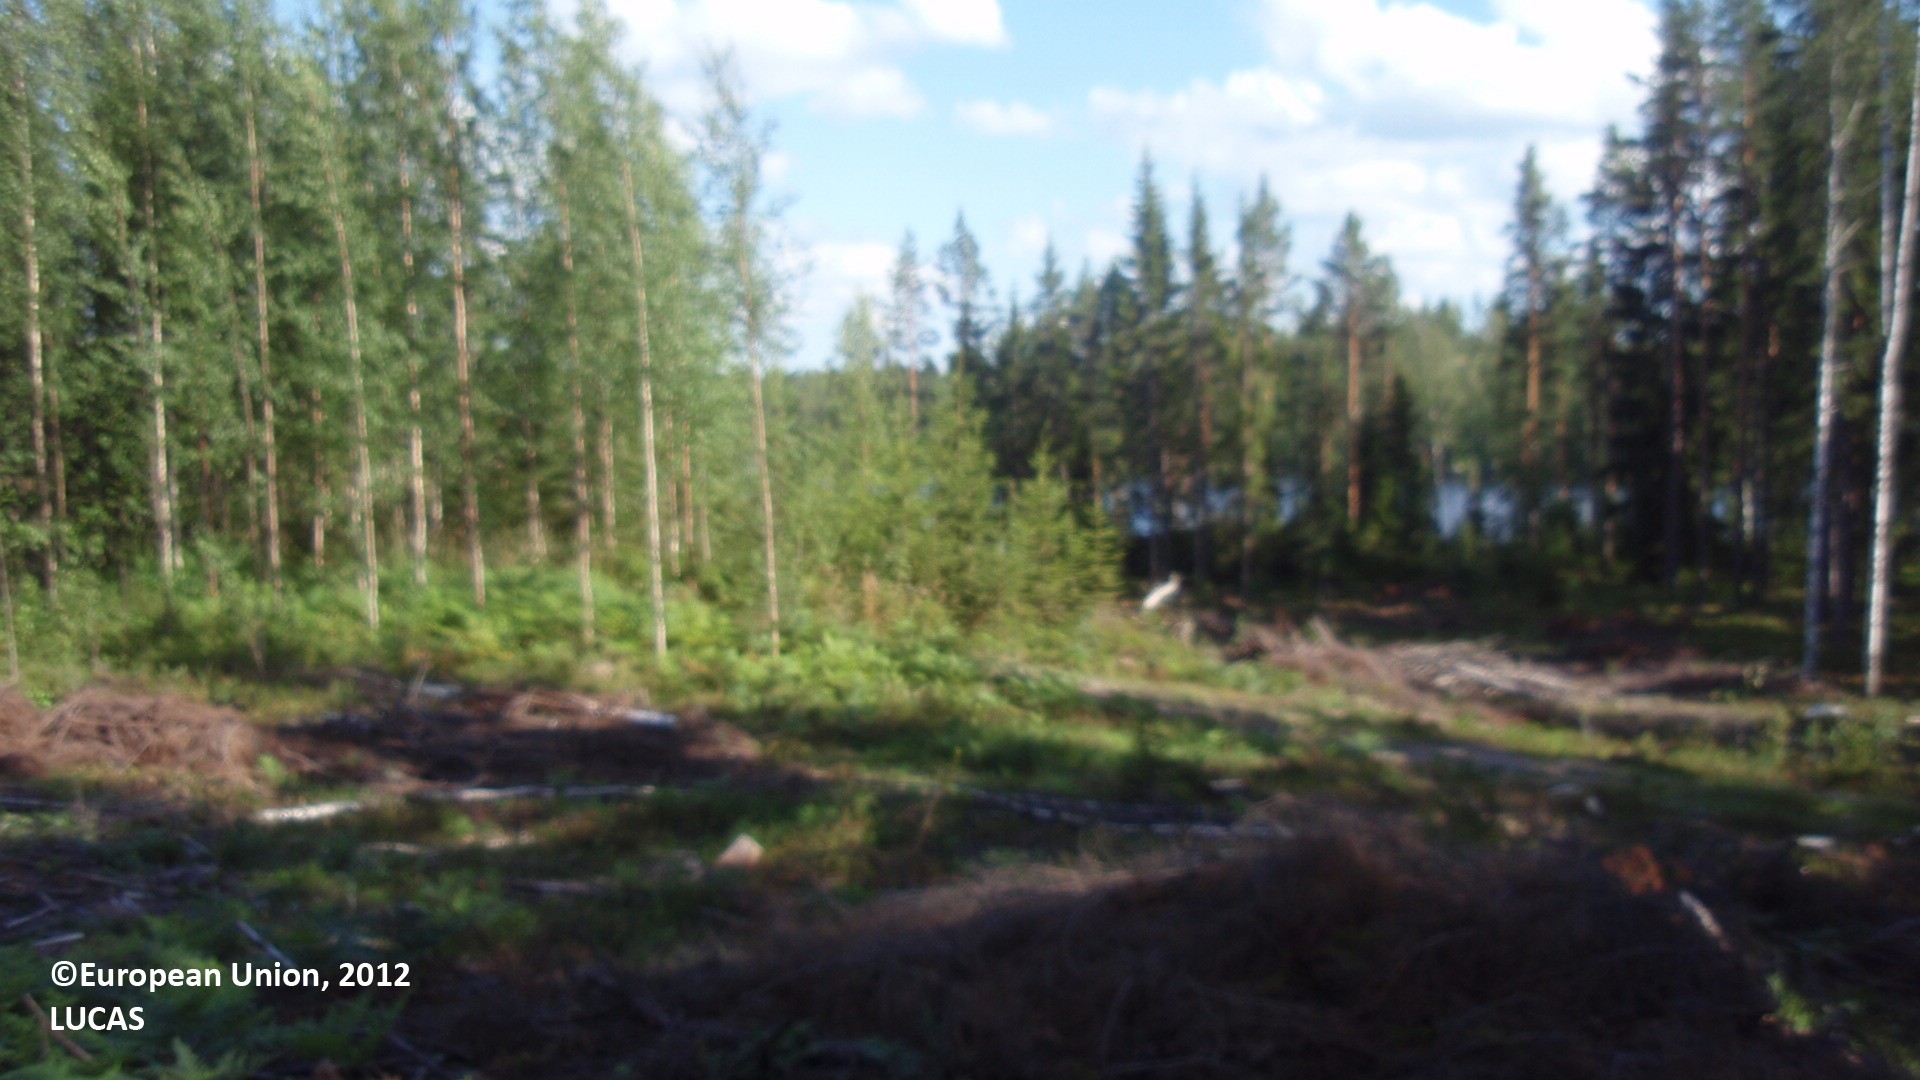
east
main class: Grassland
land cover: Grassland with sparse tree/shrub cover
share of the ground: 25 - 50 %
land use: Forestry
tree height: < 5 m
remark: Clear cut
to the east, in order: Grassland with sparse tree/shrub cover; Broadleaved woodland; Tracks; Grassland with sparse tree/shrub cover; Spruce dominated coniferous woodland; Shrubland with sparse tree cover; Spruce dominated coniferous woodland; Tracks; Spruce dominated coniferous woodland; Lichens and moss; Inland water bodies
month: July
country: FI
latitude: 61.1641
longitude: 28.2540
